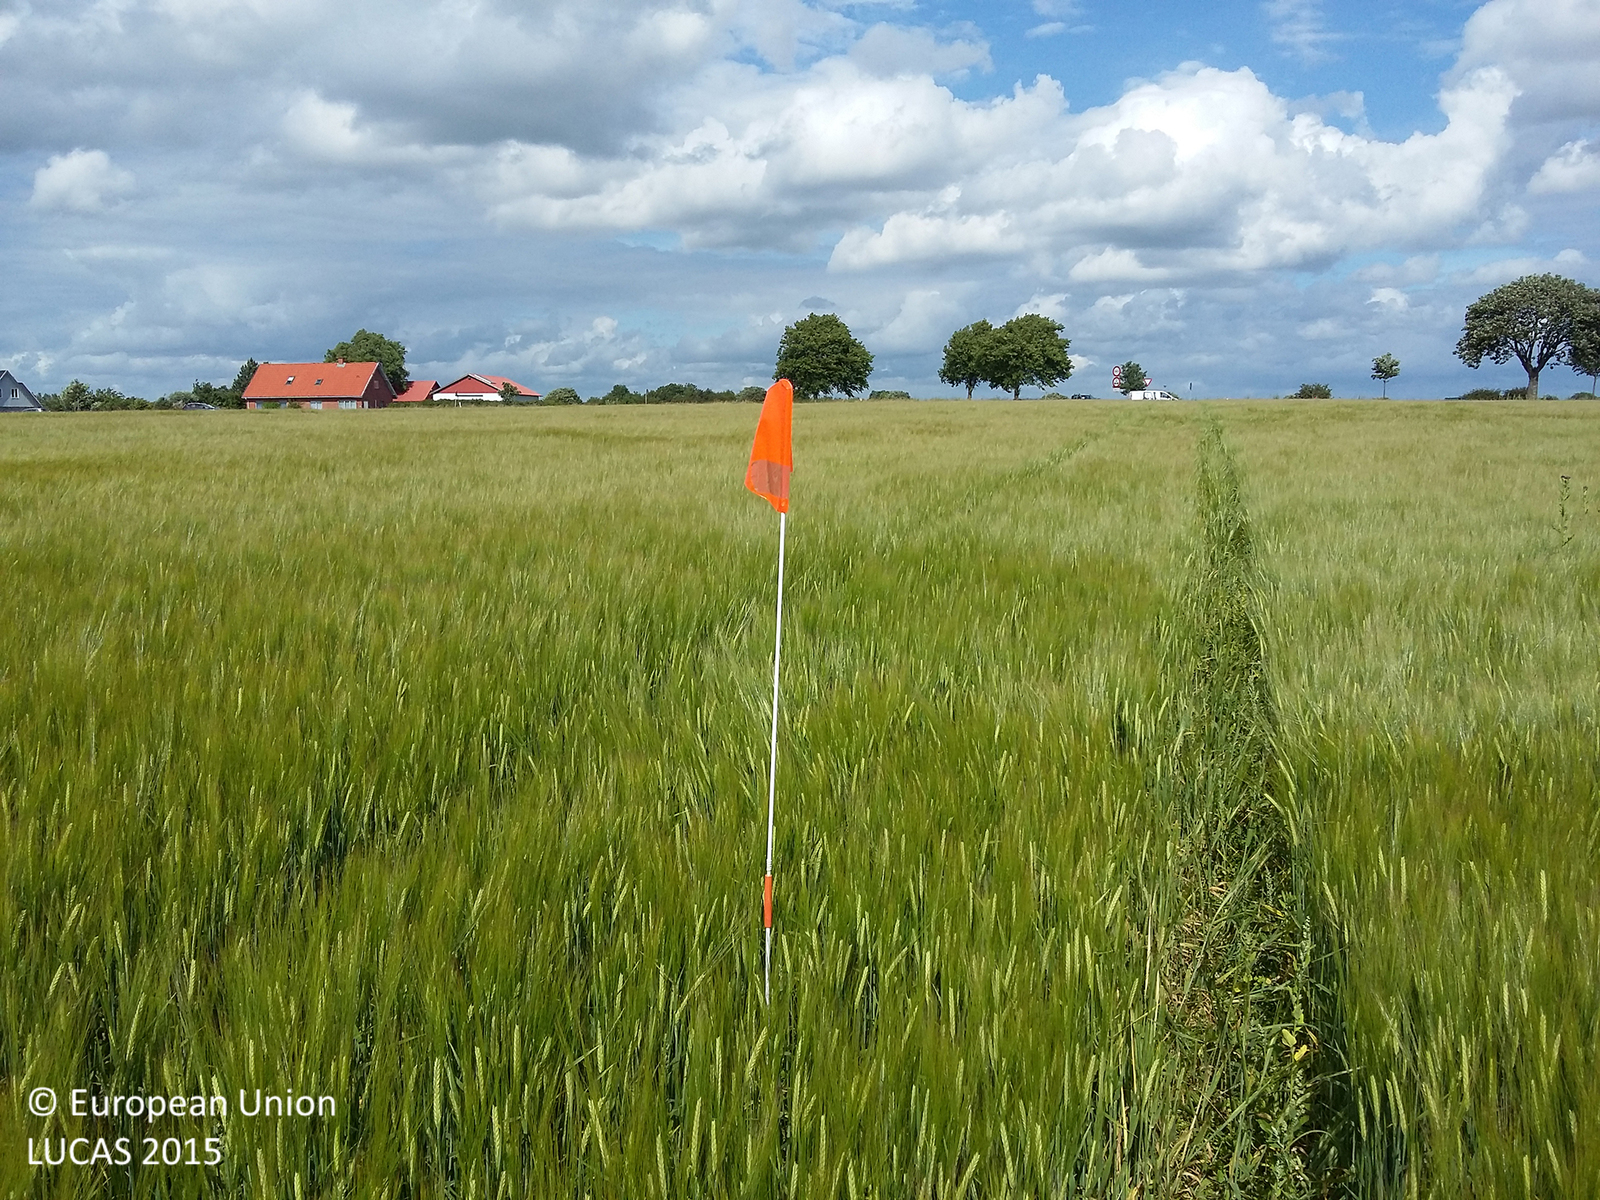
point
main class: Cropland
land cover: Barley
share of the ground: > 75 %
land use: Agriculture (excluding fallow land and kitchen gardens)
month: July
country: DK
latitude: 55.1867
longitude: 11.7735
